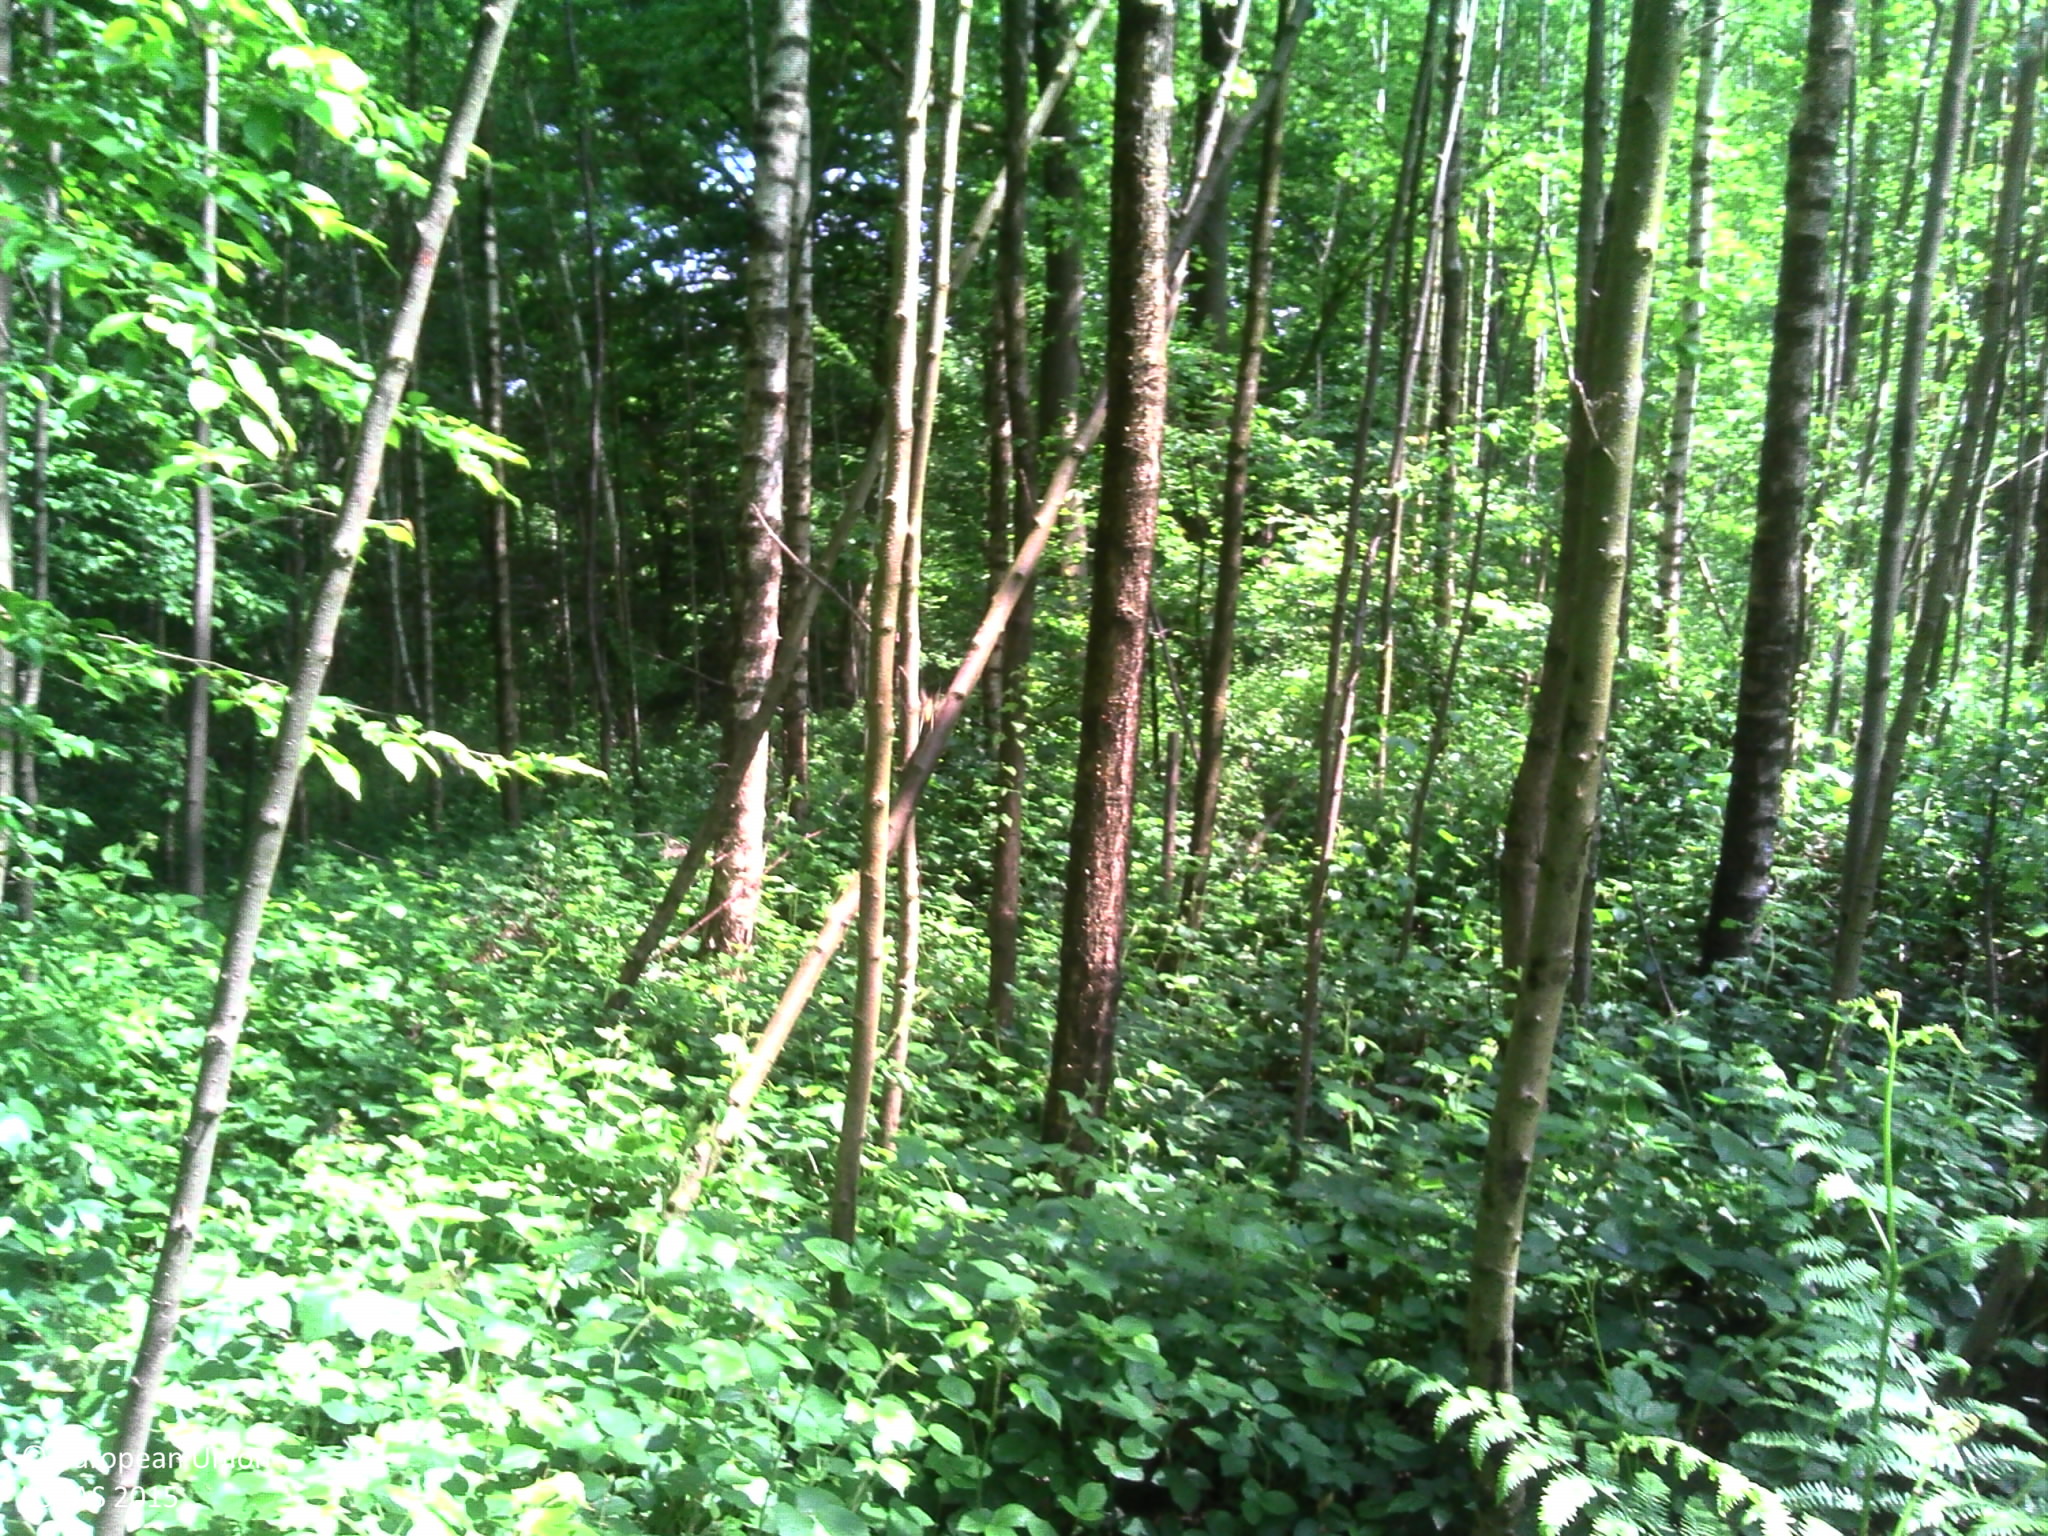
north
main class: Woodland
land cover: Broadleaved woodland
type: acidophilous oak and oak-birch forest
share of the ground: > 75 %
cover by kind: broadleaved forest trees 100 %
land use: Forestry
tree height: > 5 m
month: May
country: BE
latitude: 50.6102
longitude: 4.4987
